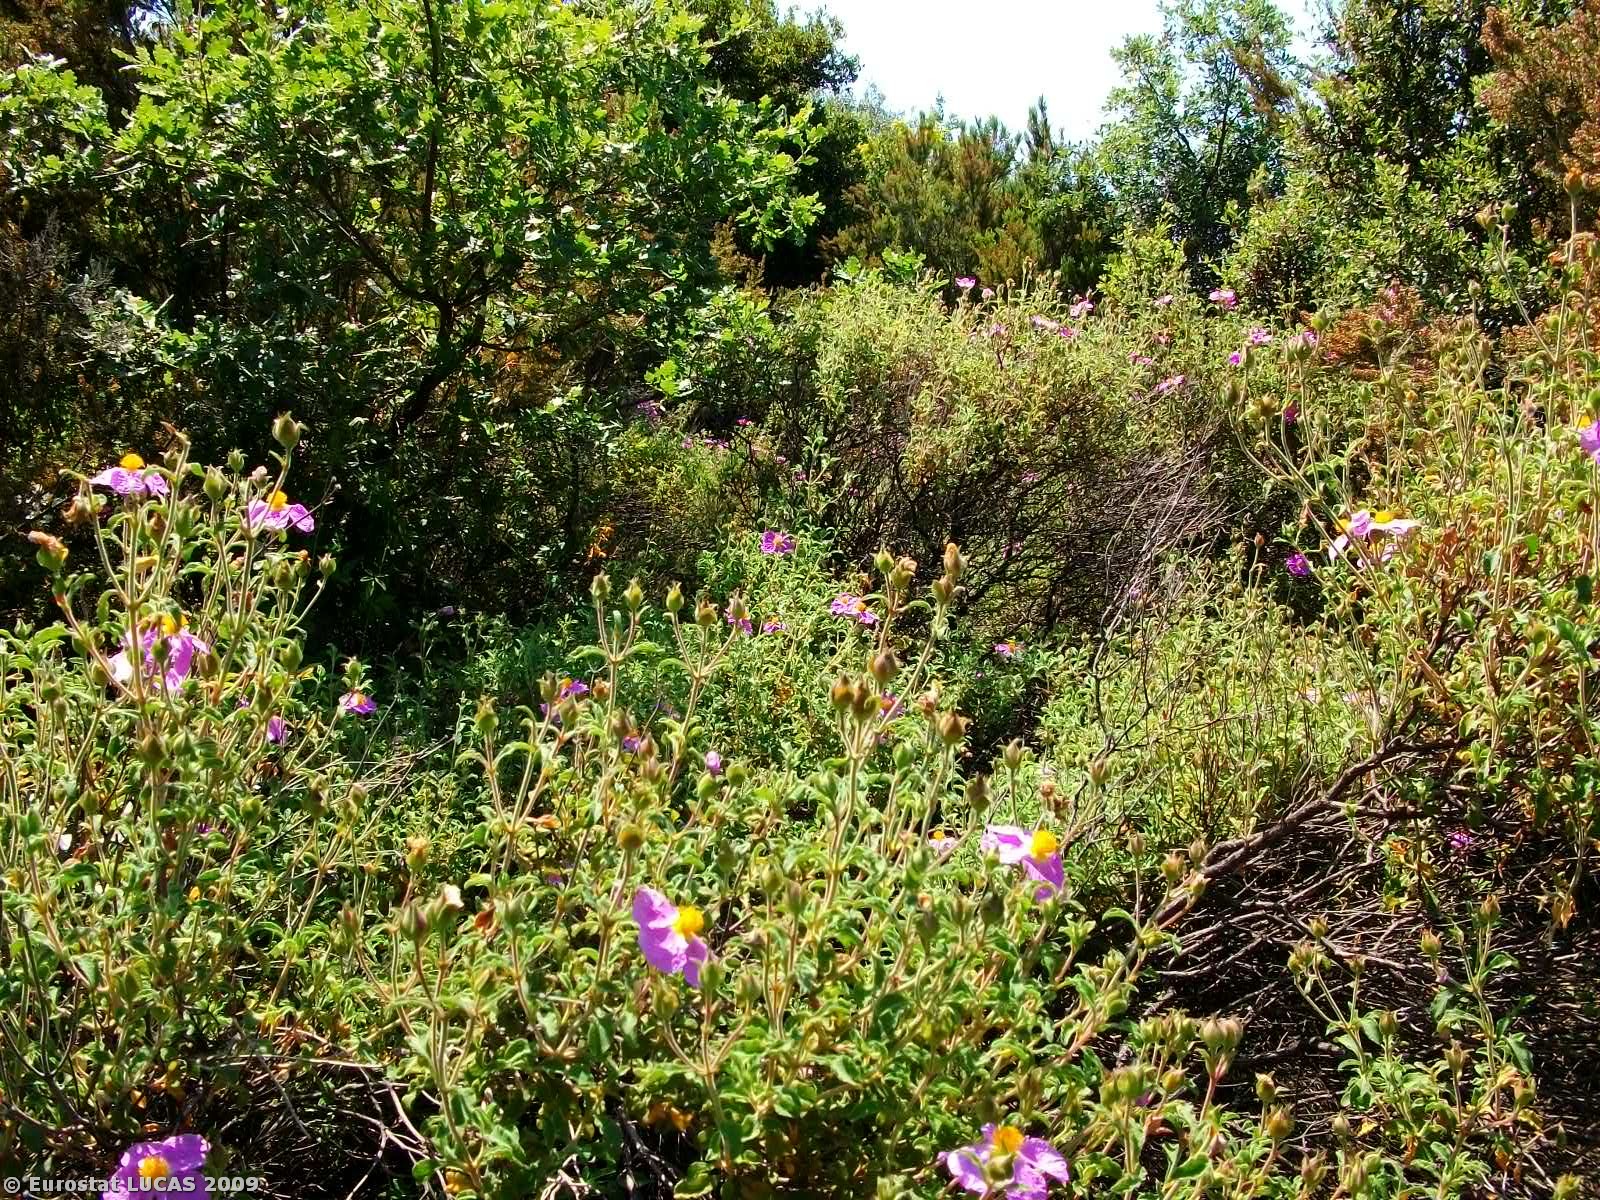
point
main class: Shrubland
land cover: Shrubland with sparse tree cover
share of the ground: > 75 %
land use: Unused
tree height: < 5 m
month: May
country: GR
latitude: 38.6628
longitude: 21.4516
